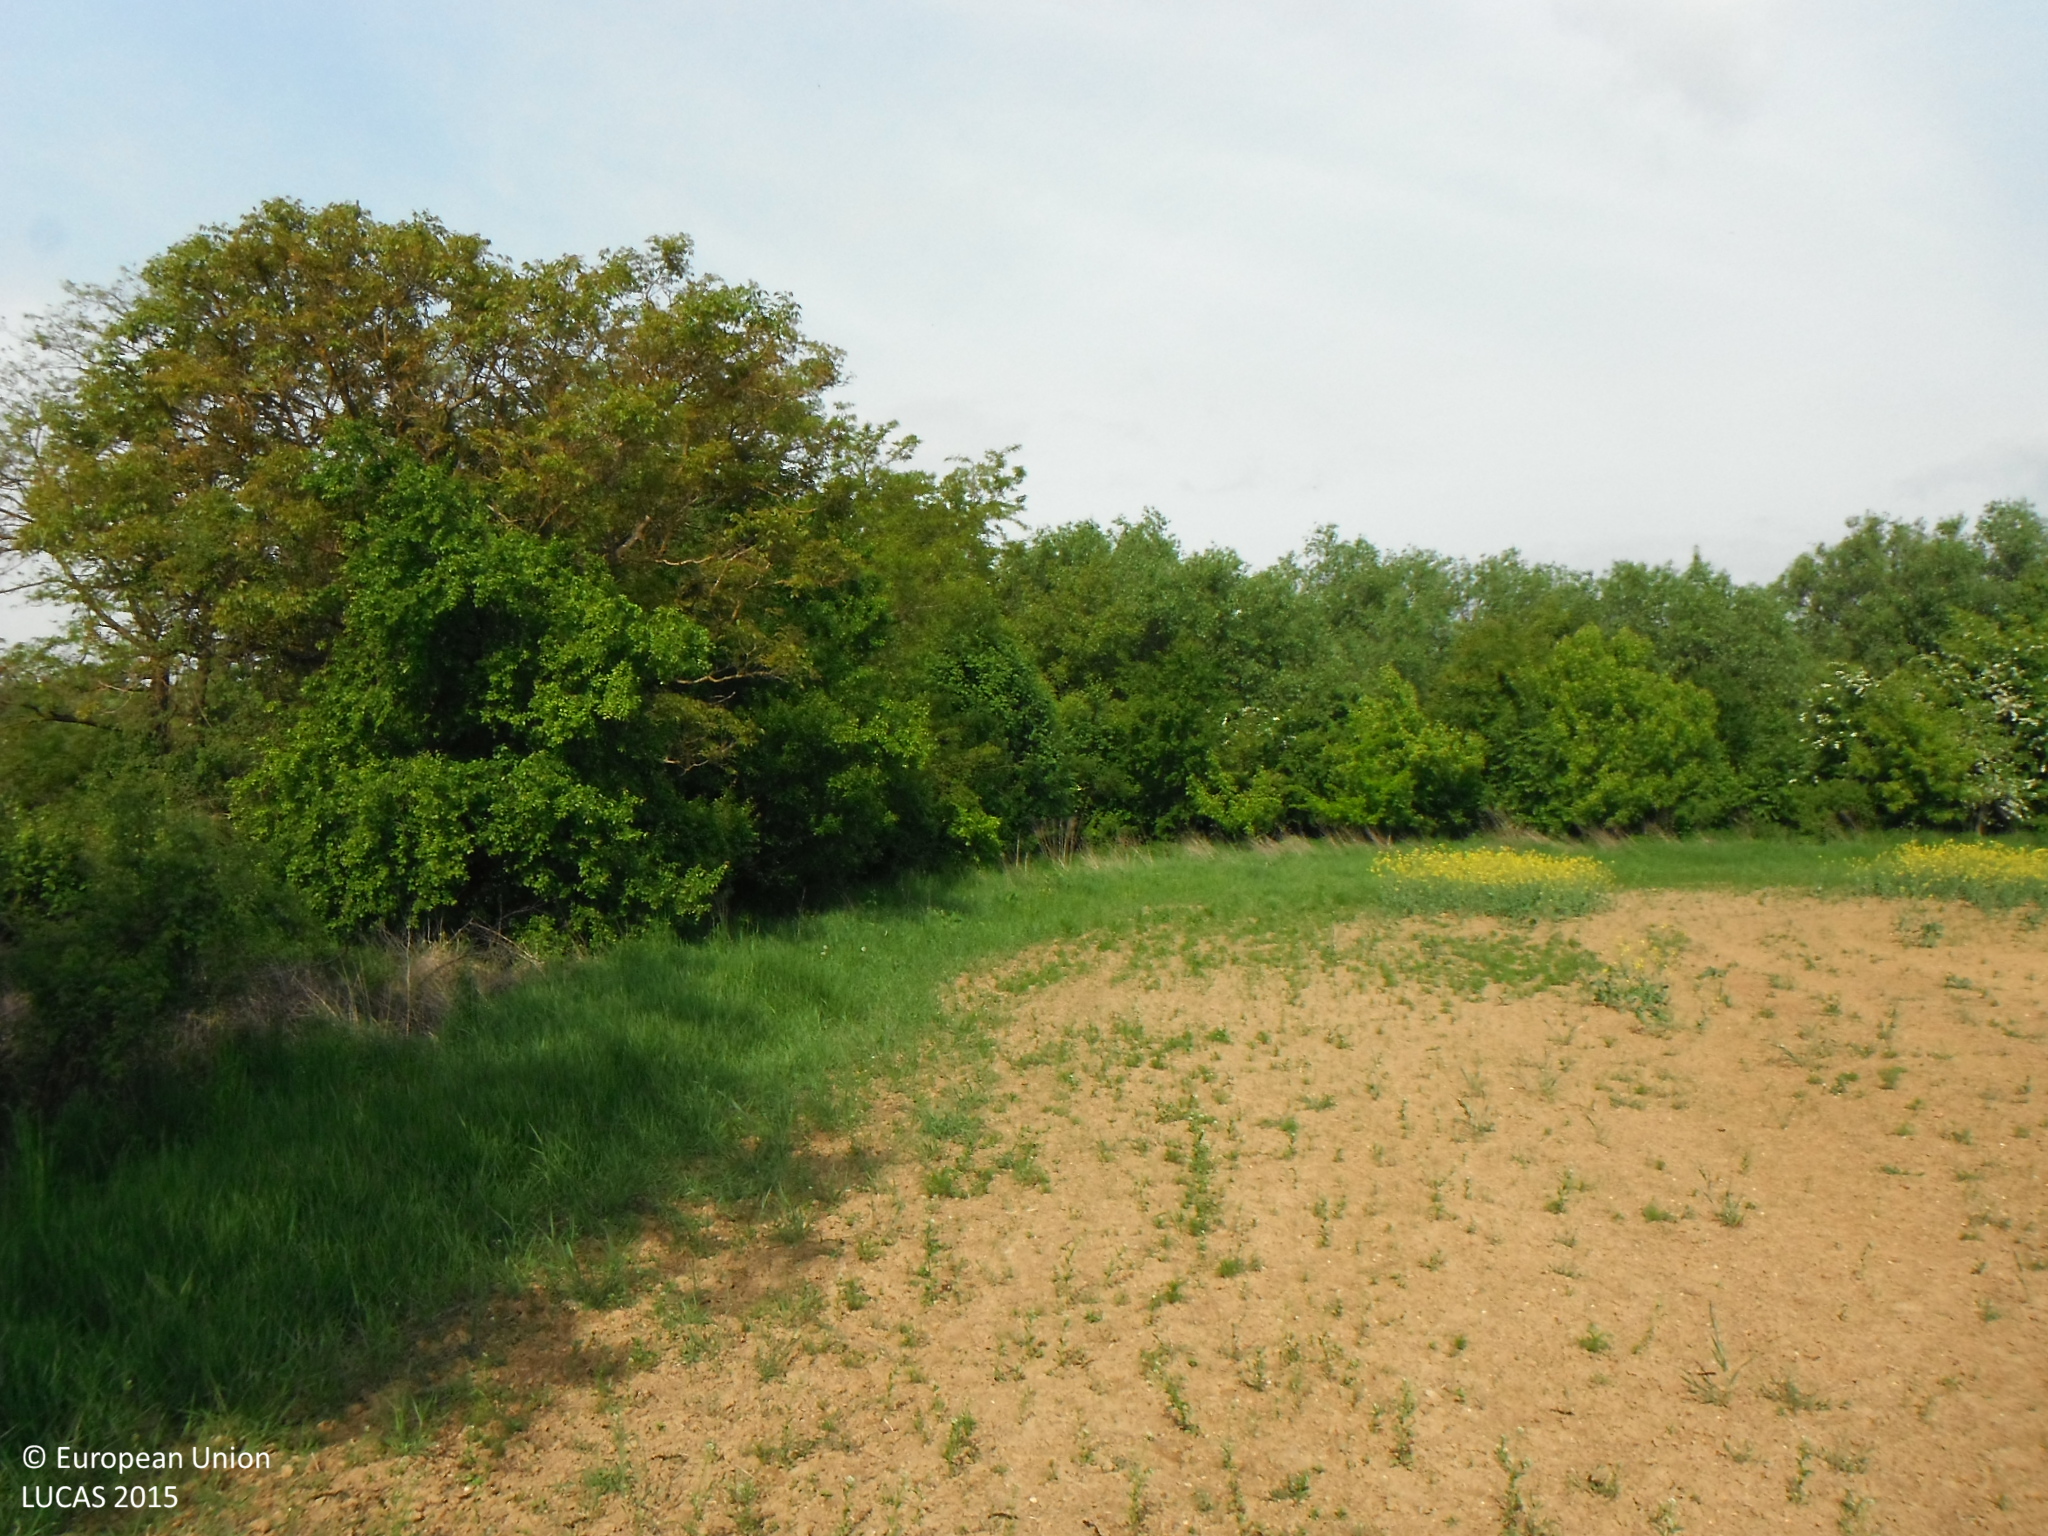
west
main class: Cropland
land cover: Rape and turnip rape
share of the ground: < 10 %
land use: Agriculture (excluding fallow land and kitchen gardens)
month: May
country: SK
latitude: 48.6005
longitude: 21.1489
